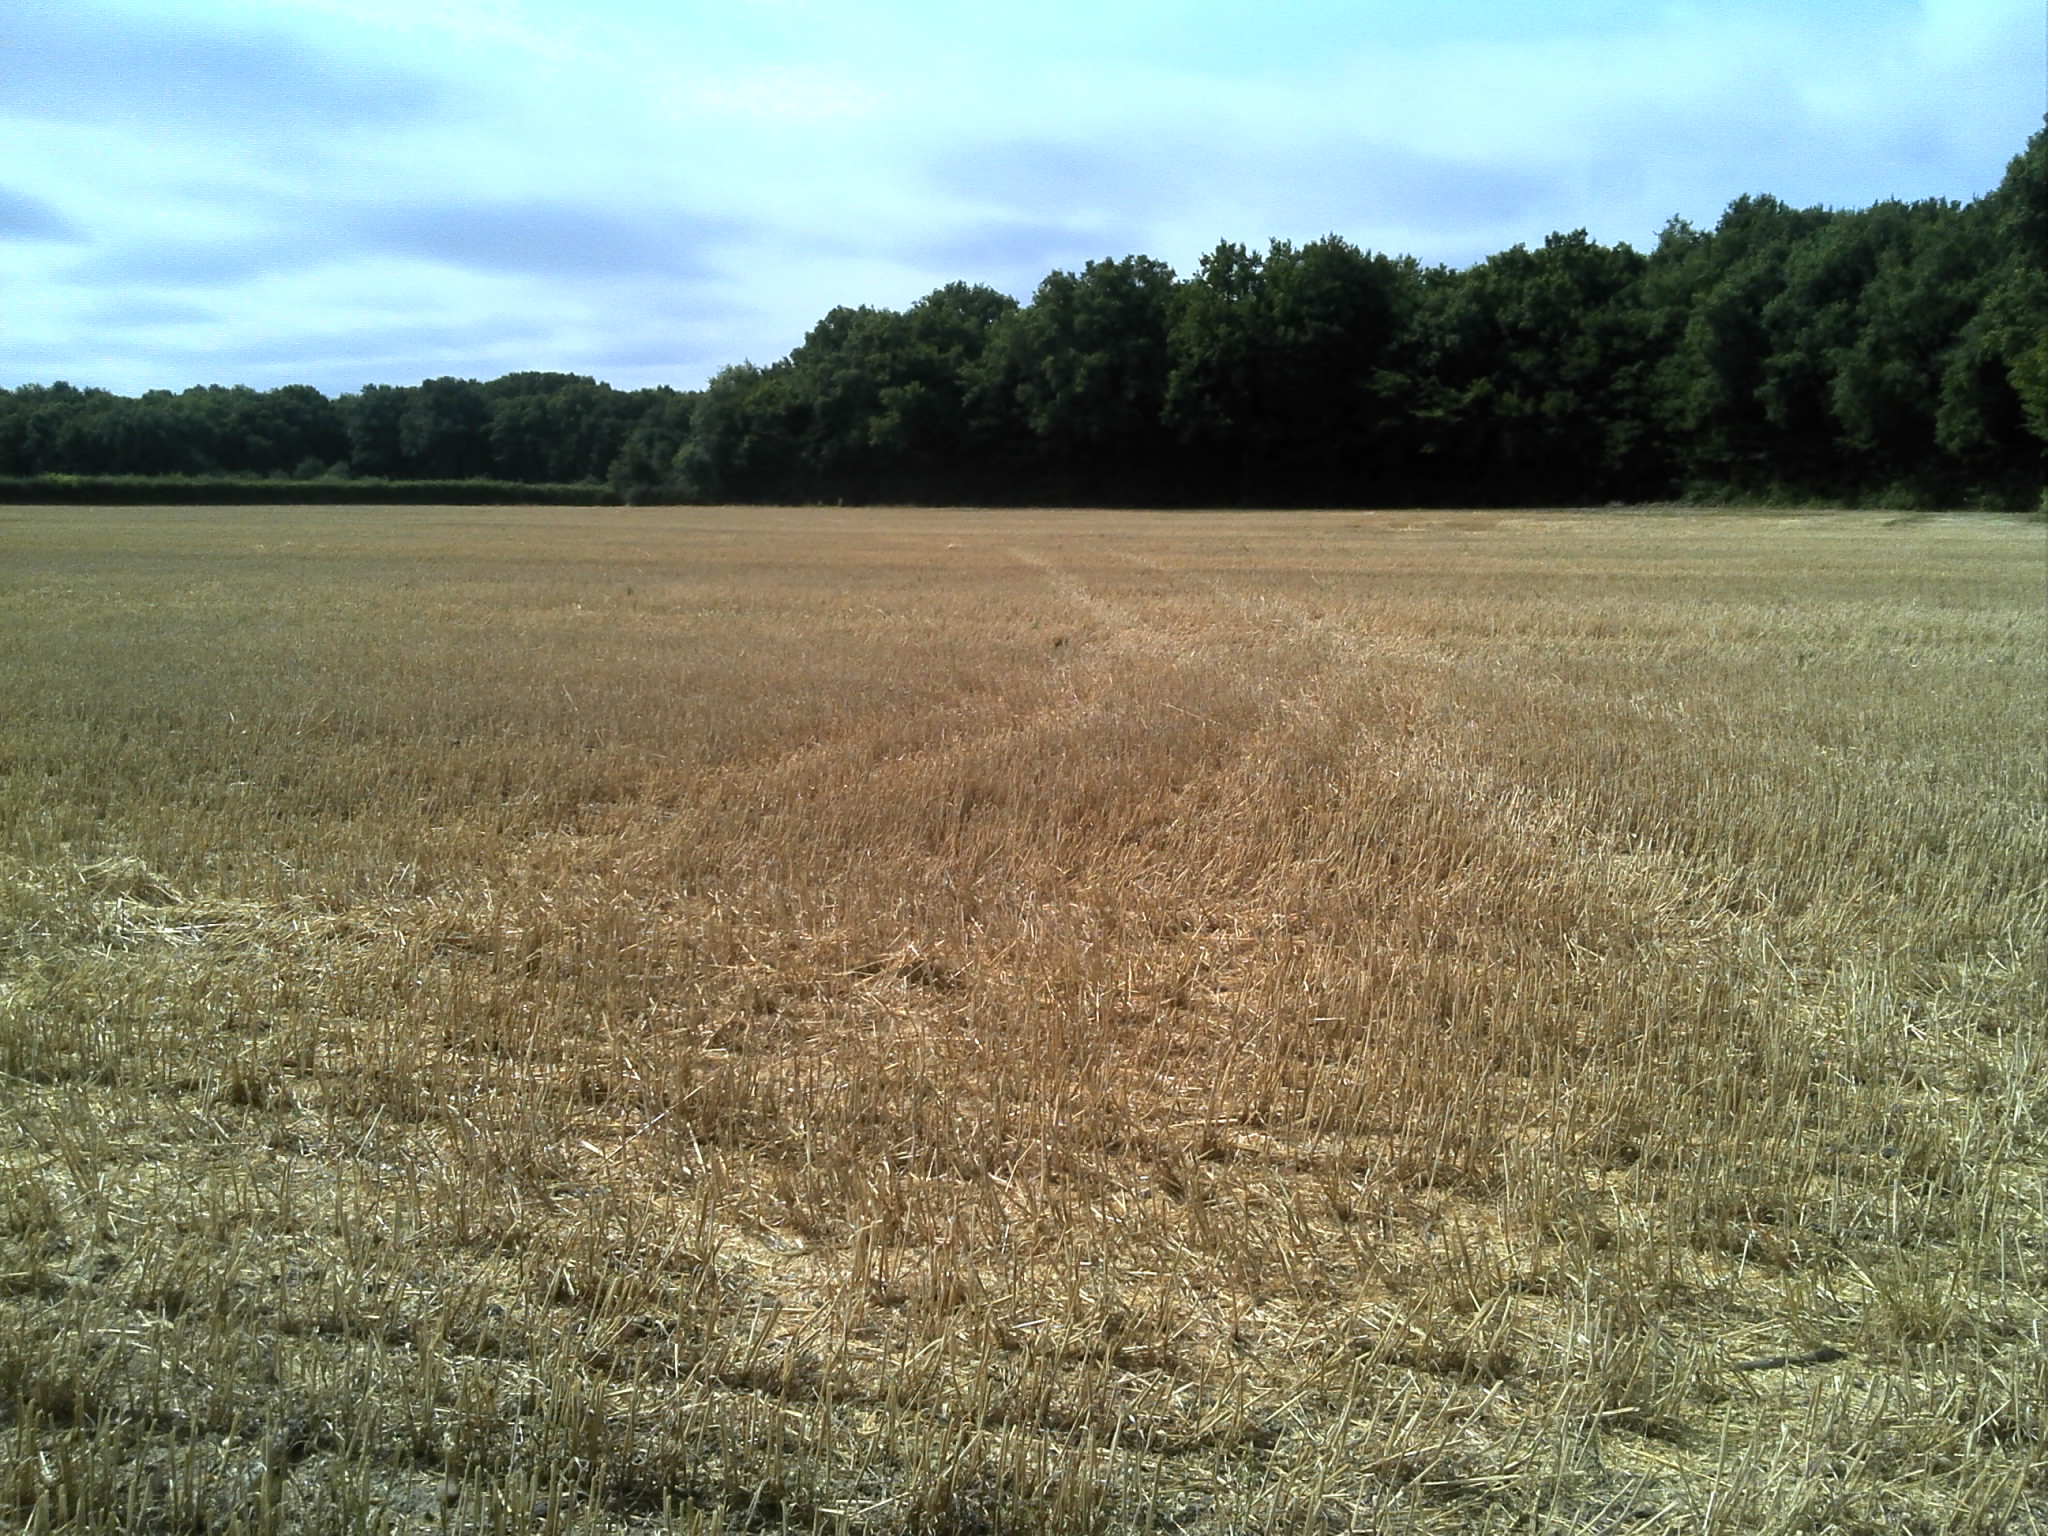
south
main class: Cropland
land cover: Durum wheat
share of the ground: 10 - 25 %
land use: Agriculture (excluding fallow land and kitchen gardens)
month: July
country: FR
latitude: 46.7940
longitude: 1.5387
